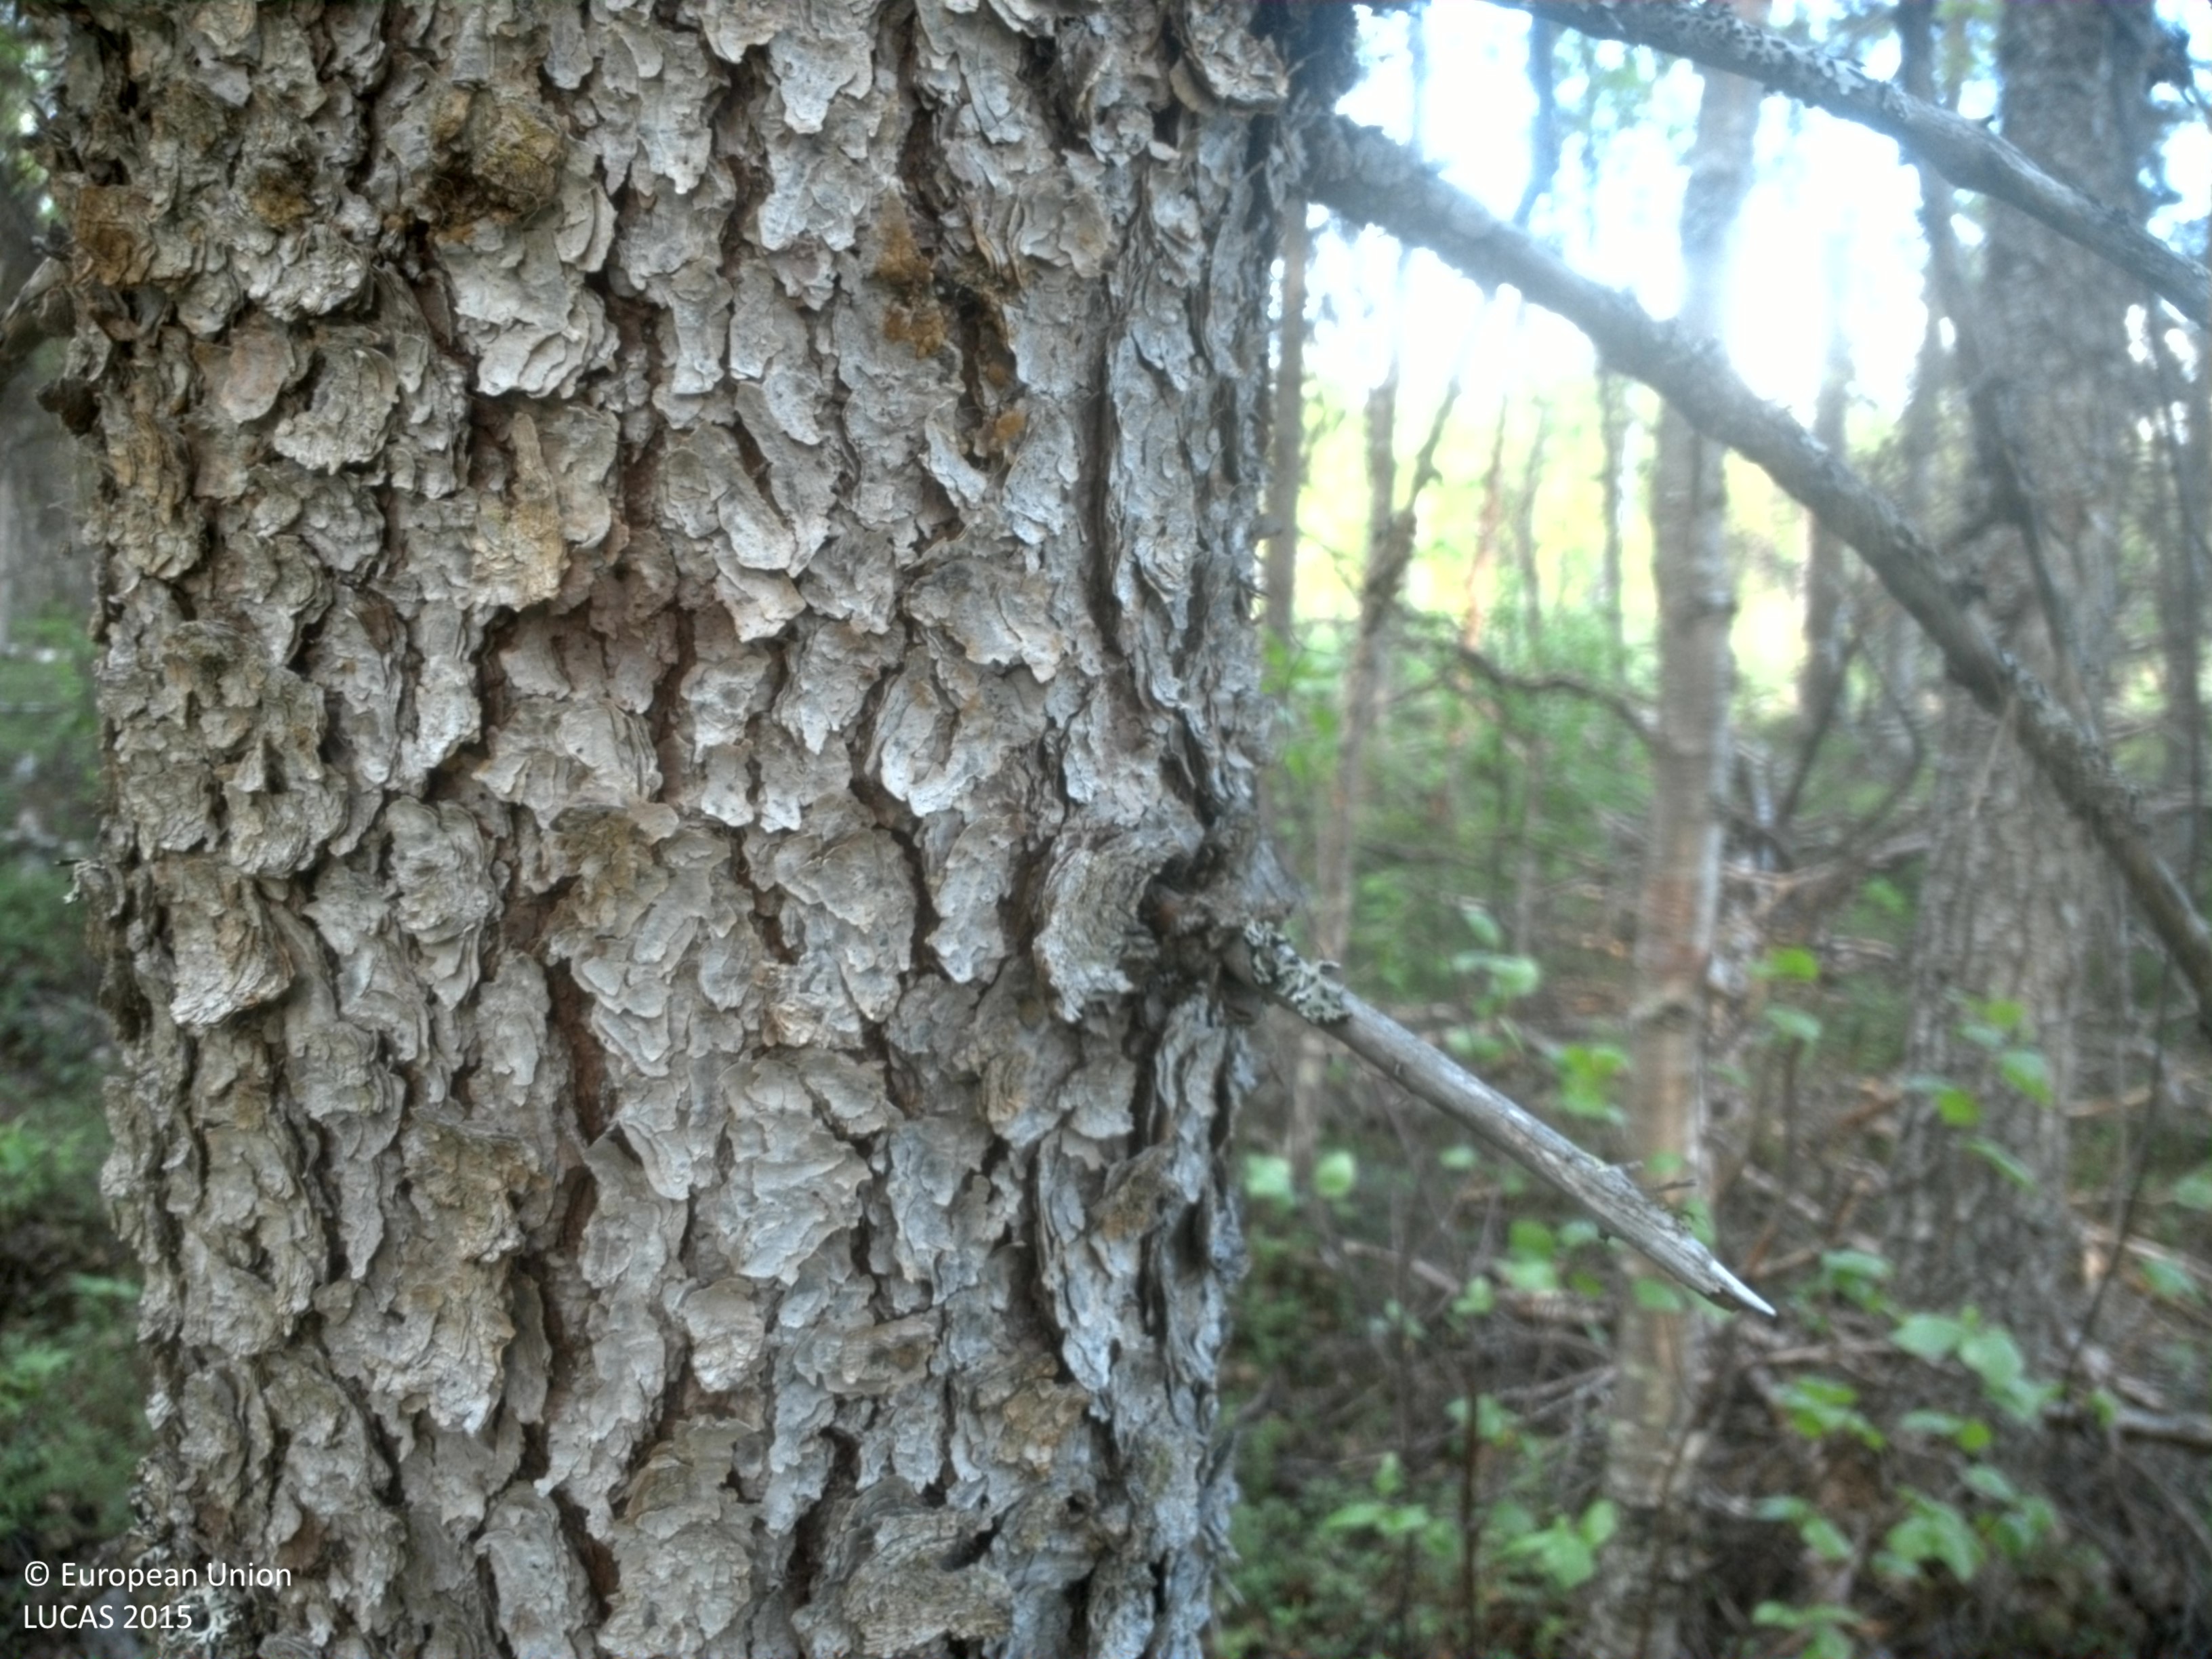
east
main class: Woodland
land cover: Spruce dominated mixed woodland
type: boreal forest
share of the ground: 50 - 75 %
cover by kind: shrubs 45 %, coniferous forest trees 35 %, broadleaved forest trees 15 %, herbaceous plants 5 %
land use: Forestry
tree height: > 5 m
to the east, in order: Spruce dominated mixed woodland; Rivers and streams; Spruce dominated mixed woodland; Pine dominated coniferous woodland; Pine dominated mixed woodland
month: June
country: SE
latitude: 67.0991
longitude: 21.6777
